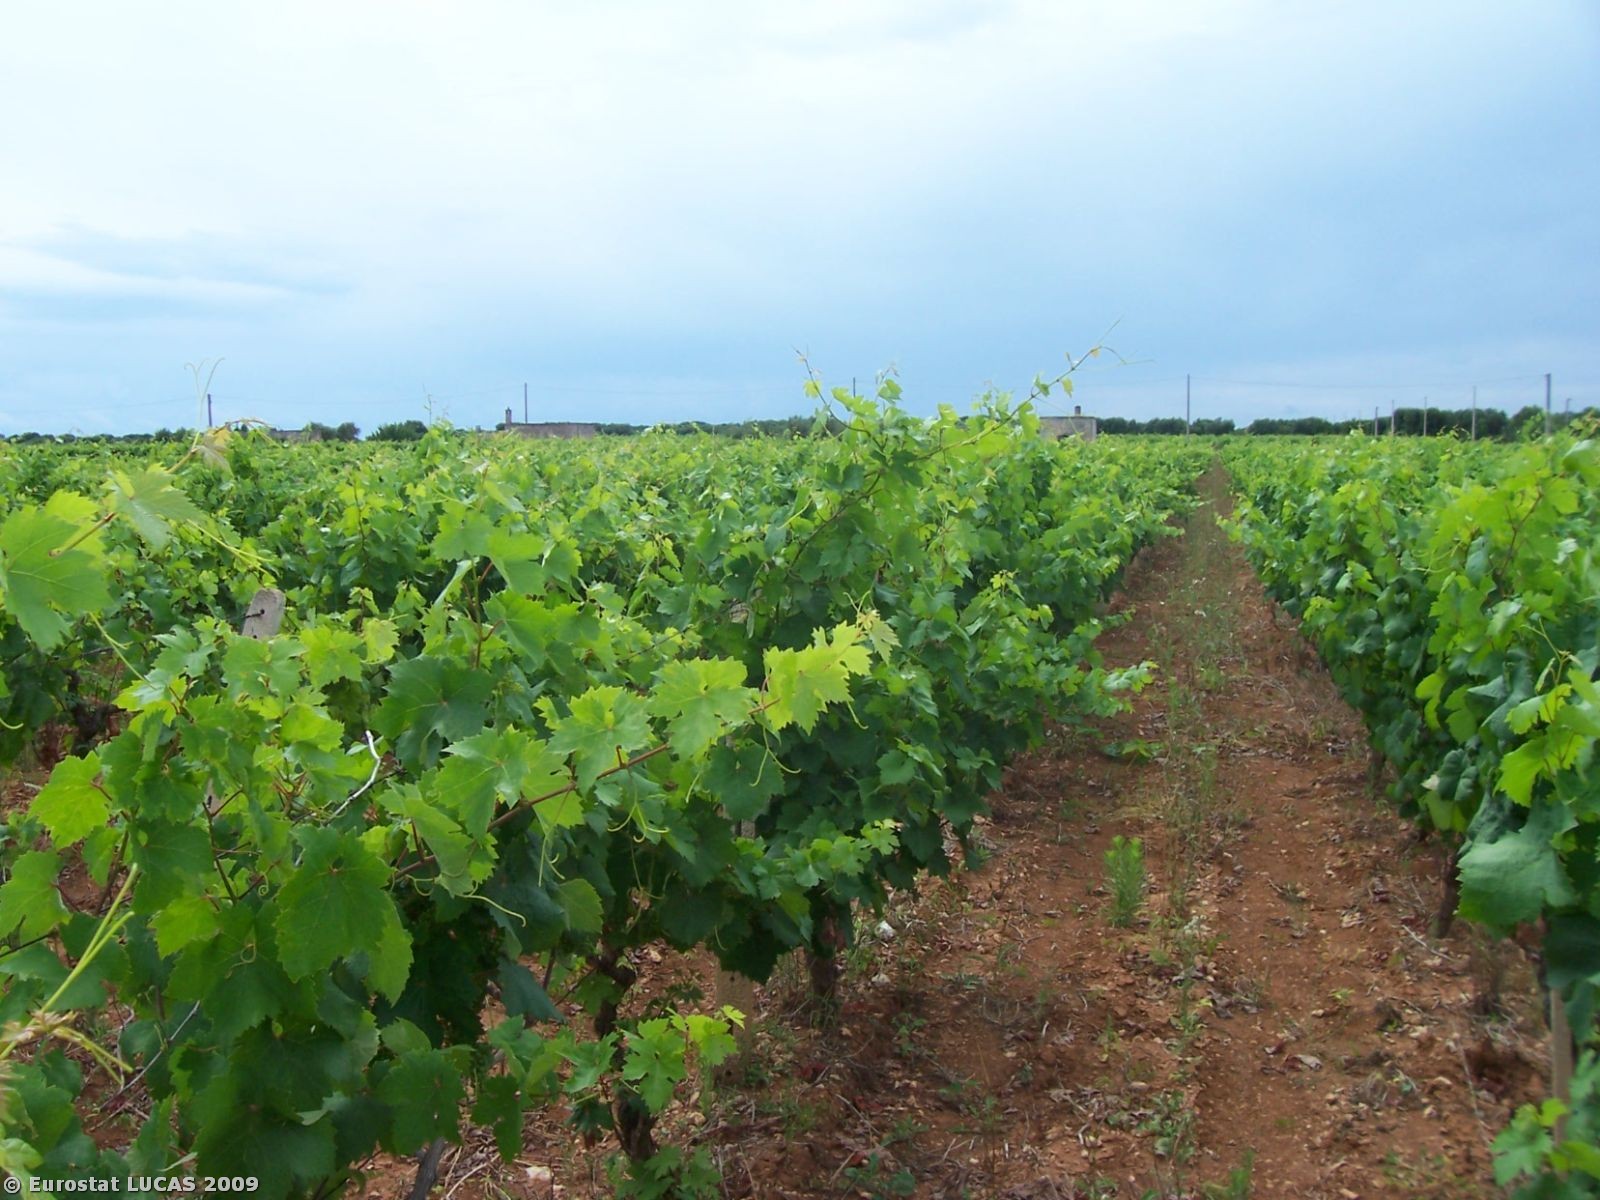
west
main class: Cropland
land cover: Vineyards
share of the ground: 25 - 50 %
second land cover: Bare land
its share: > 75 %
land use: Agriculture (excluding fallow land and kitchen gardens)
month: June
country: IT
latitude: 40.3417
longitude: 17.5207
